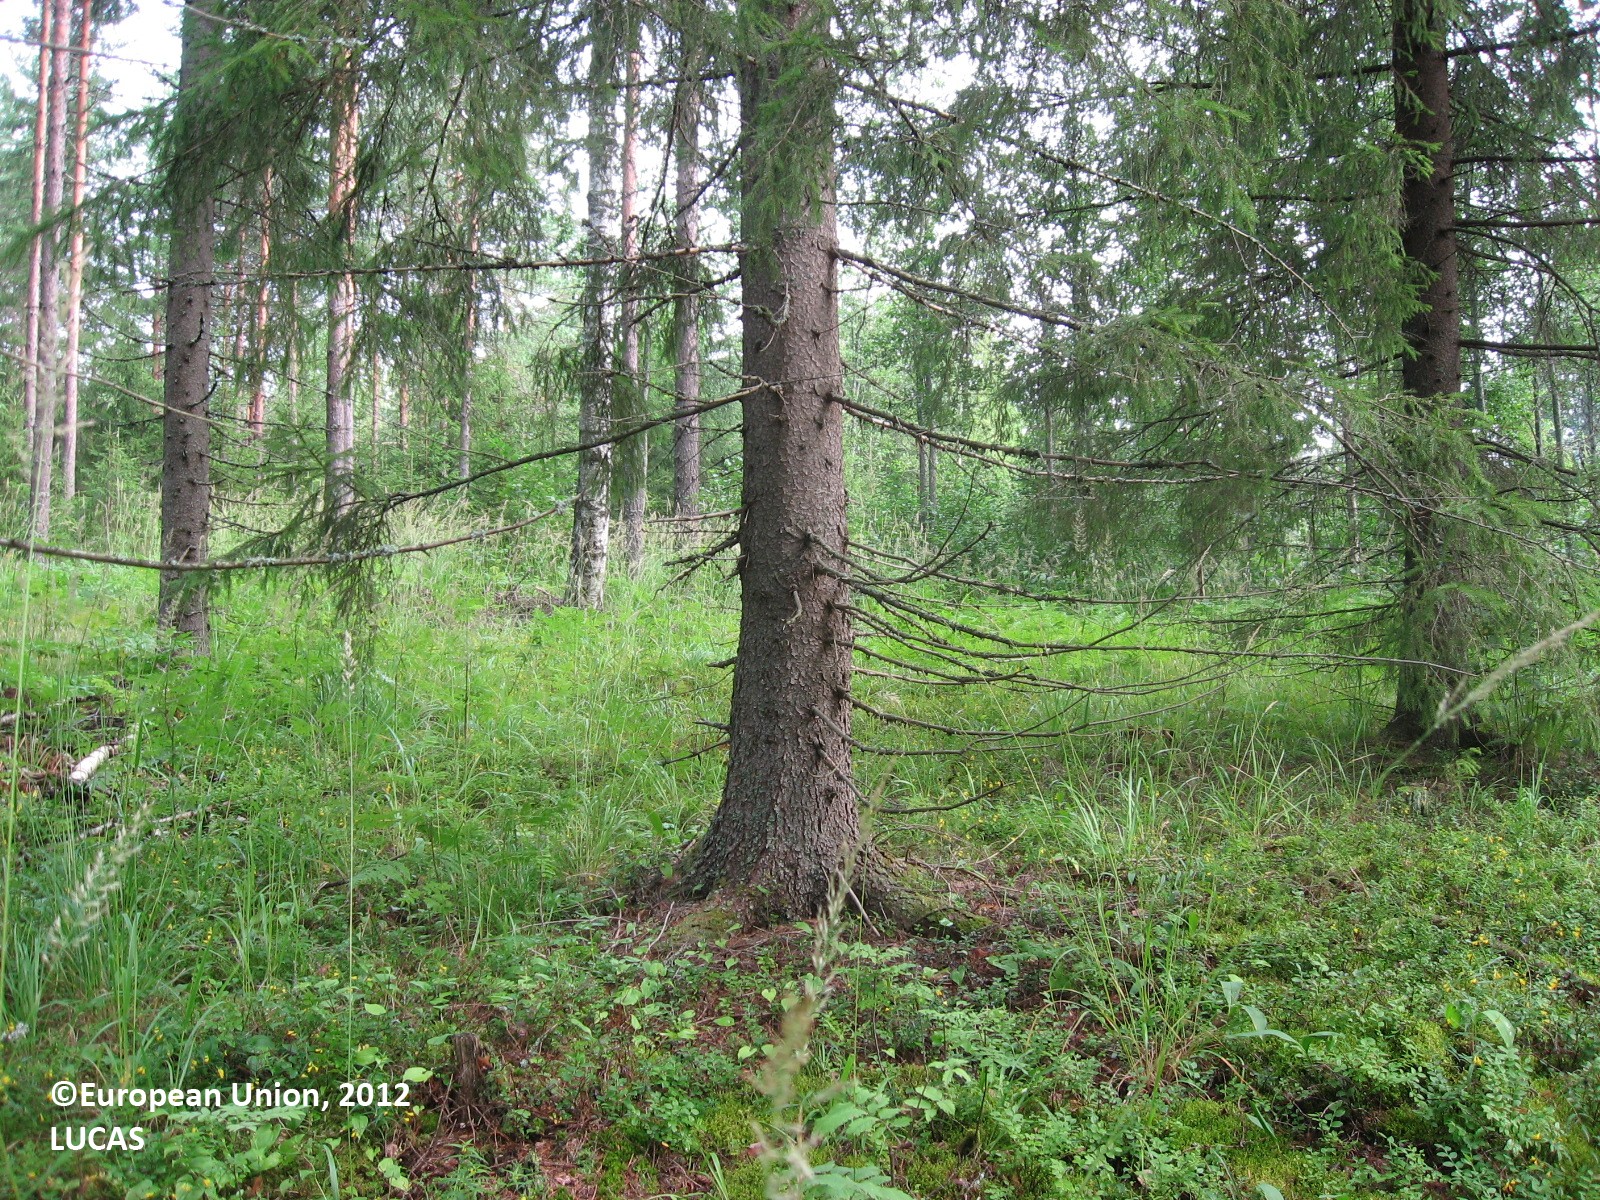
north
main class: Woodland
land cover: Spruce dominated coniferous woodland
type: boreal forest
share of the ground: 25 - 50 %
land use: Forestry
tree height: > 5 m
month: July
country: FI
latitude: 61.2447
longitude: 26.5301
